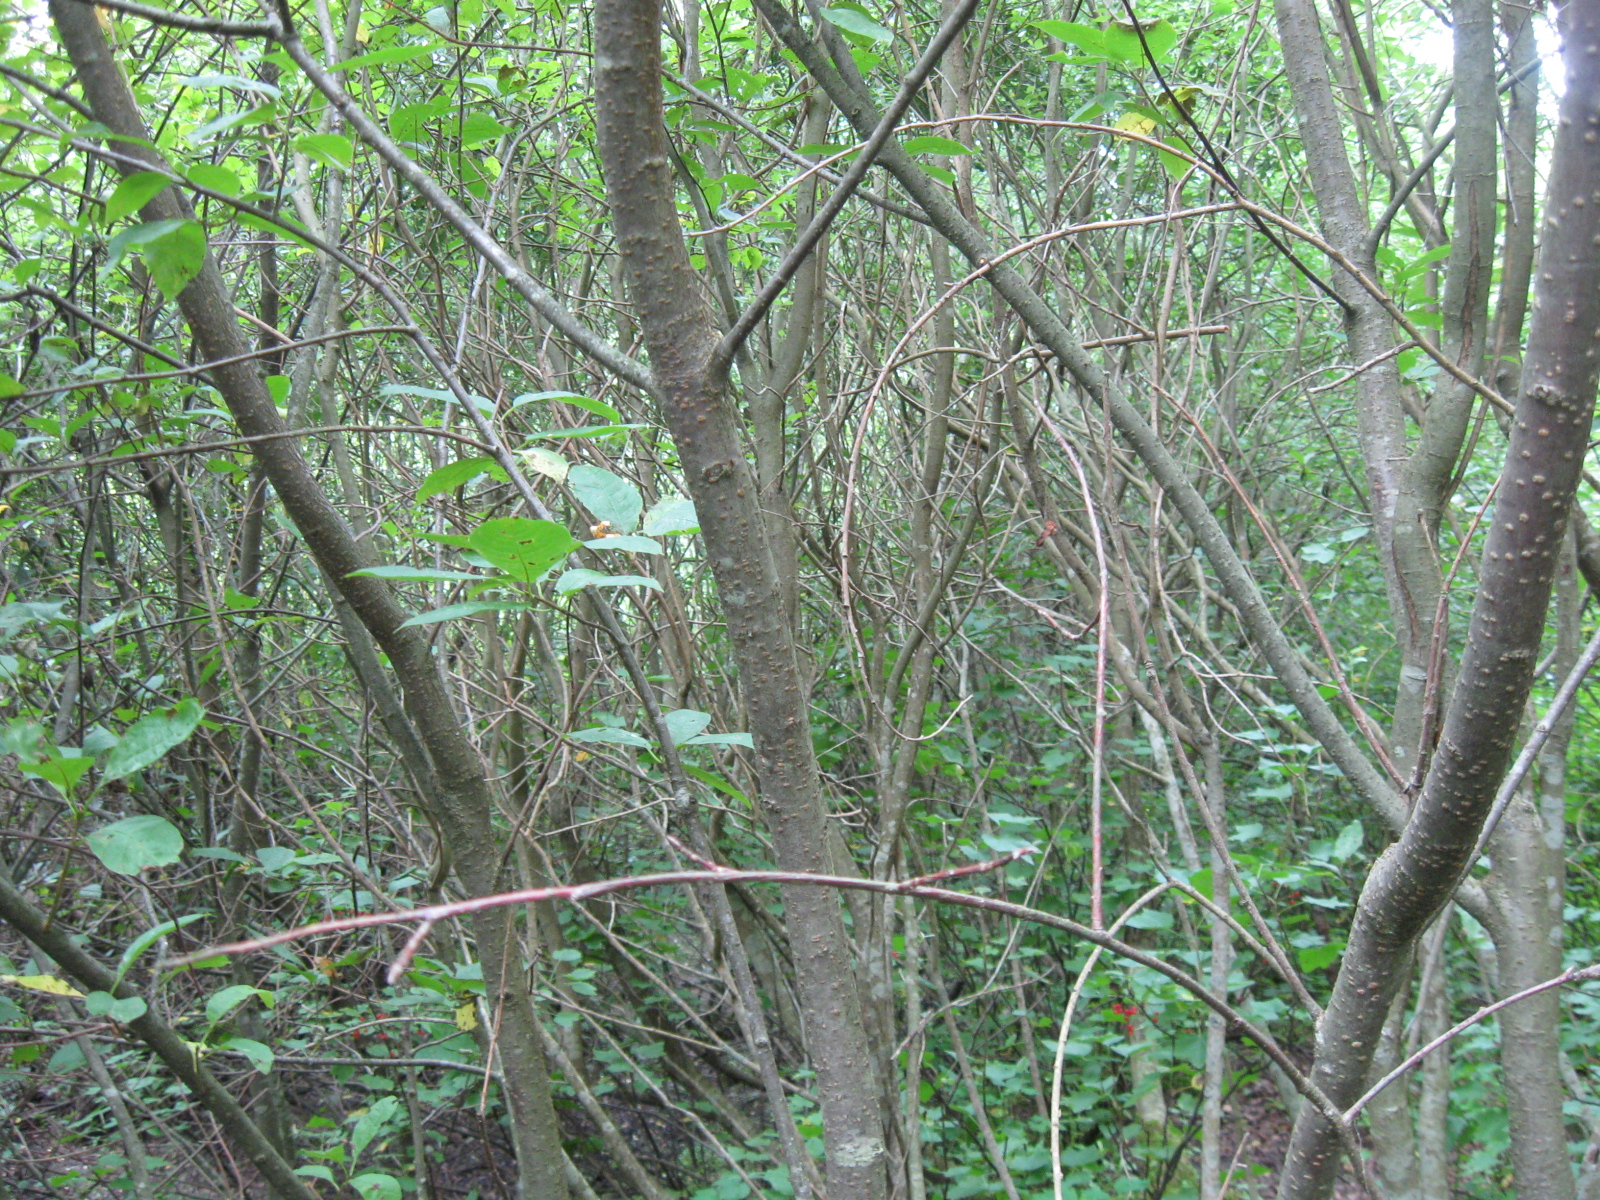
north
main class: Woodland
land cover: Broadleaved woodland
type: non-riverine alder, birch or aspen forest
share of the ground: > 75 %
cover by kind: broadleaved forest trees 85 %, herbaceous plants 10 %, coniferous forest trees 5 %
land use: Forestry
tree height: > 5 m
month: July
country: LT
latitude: 54.8611
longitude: 23.5581
